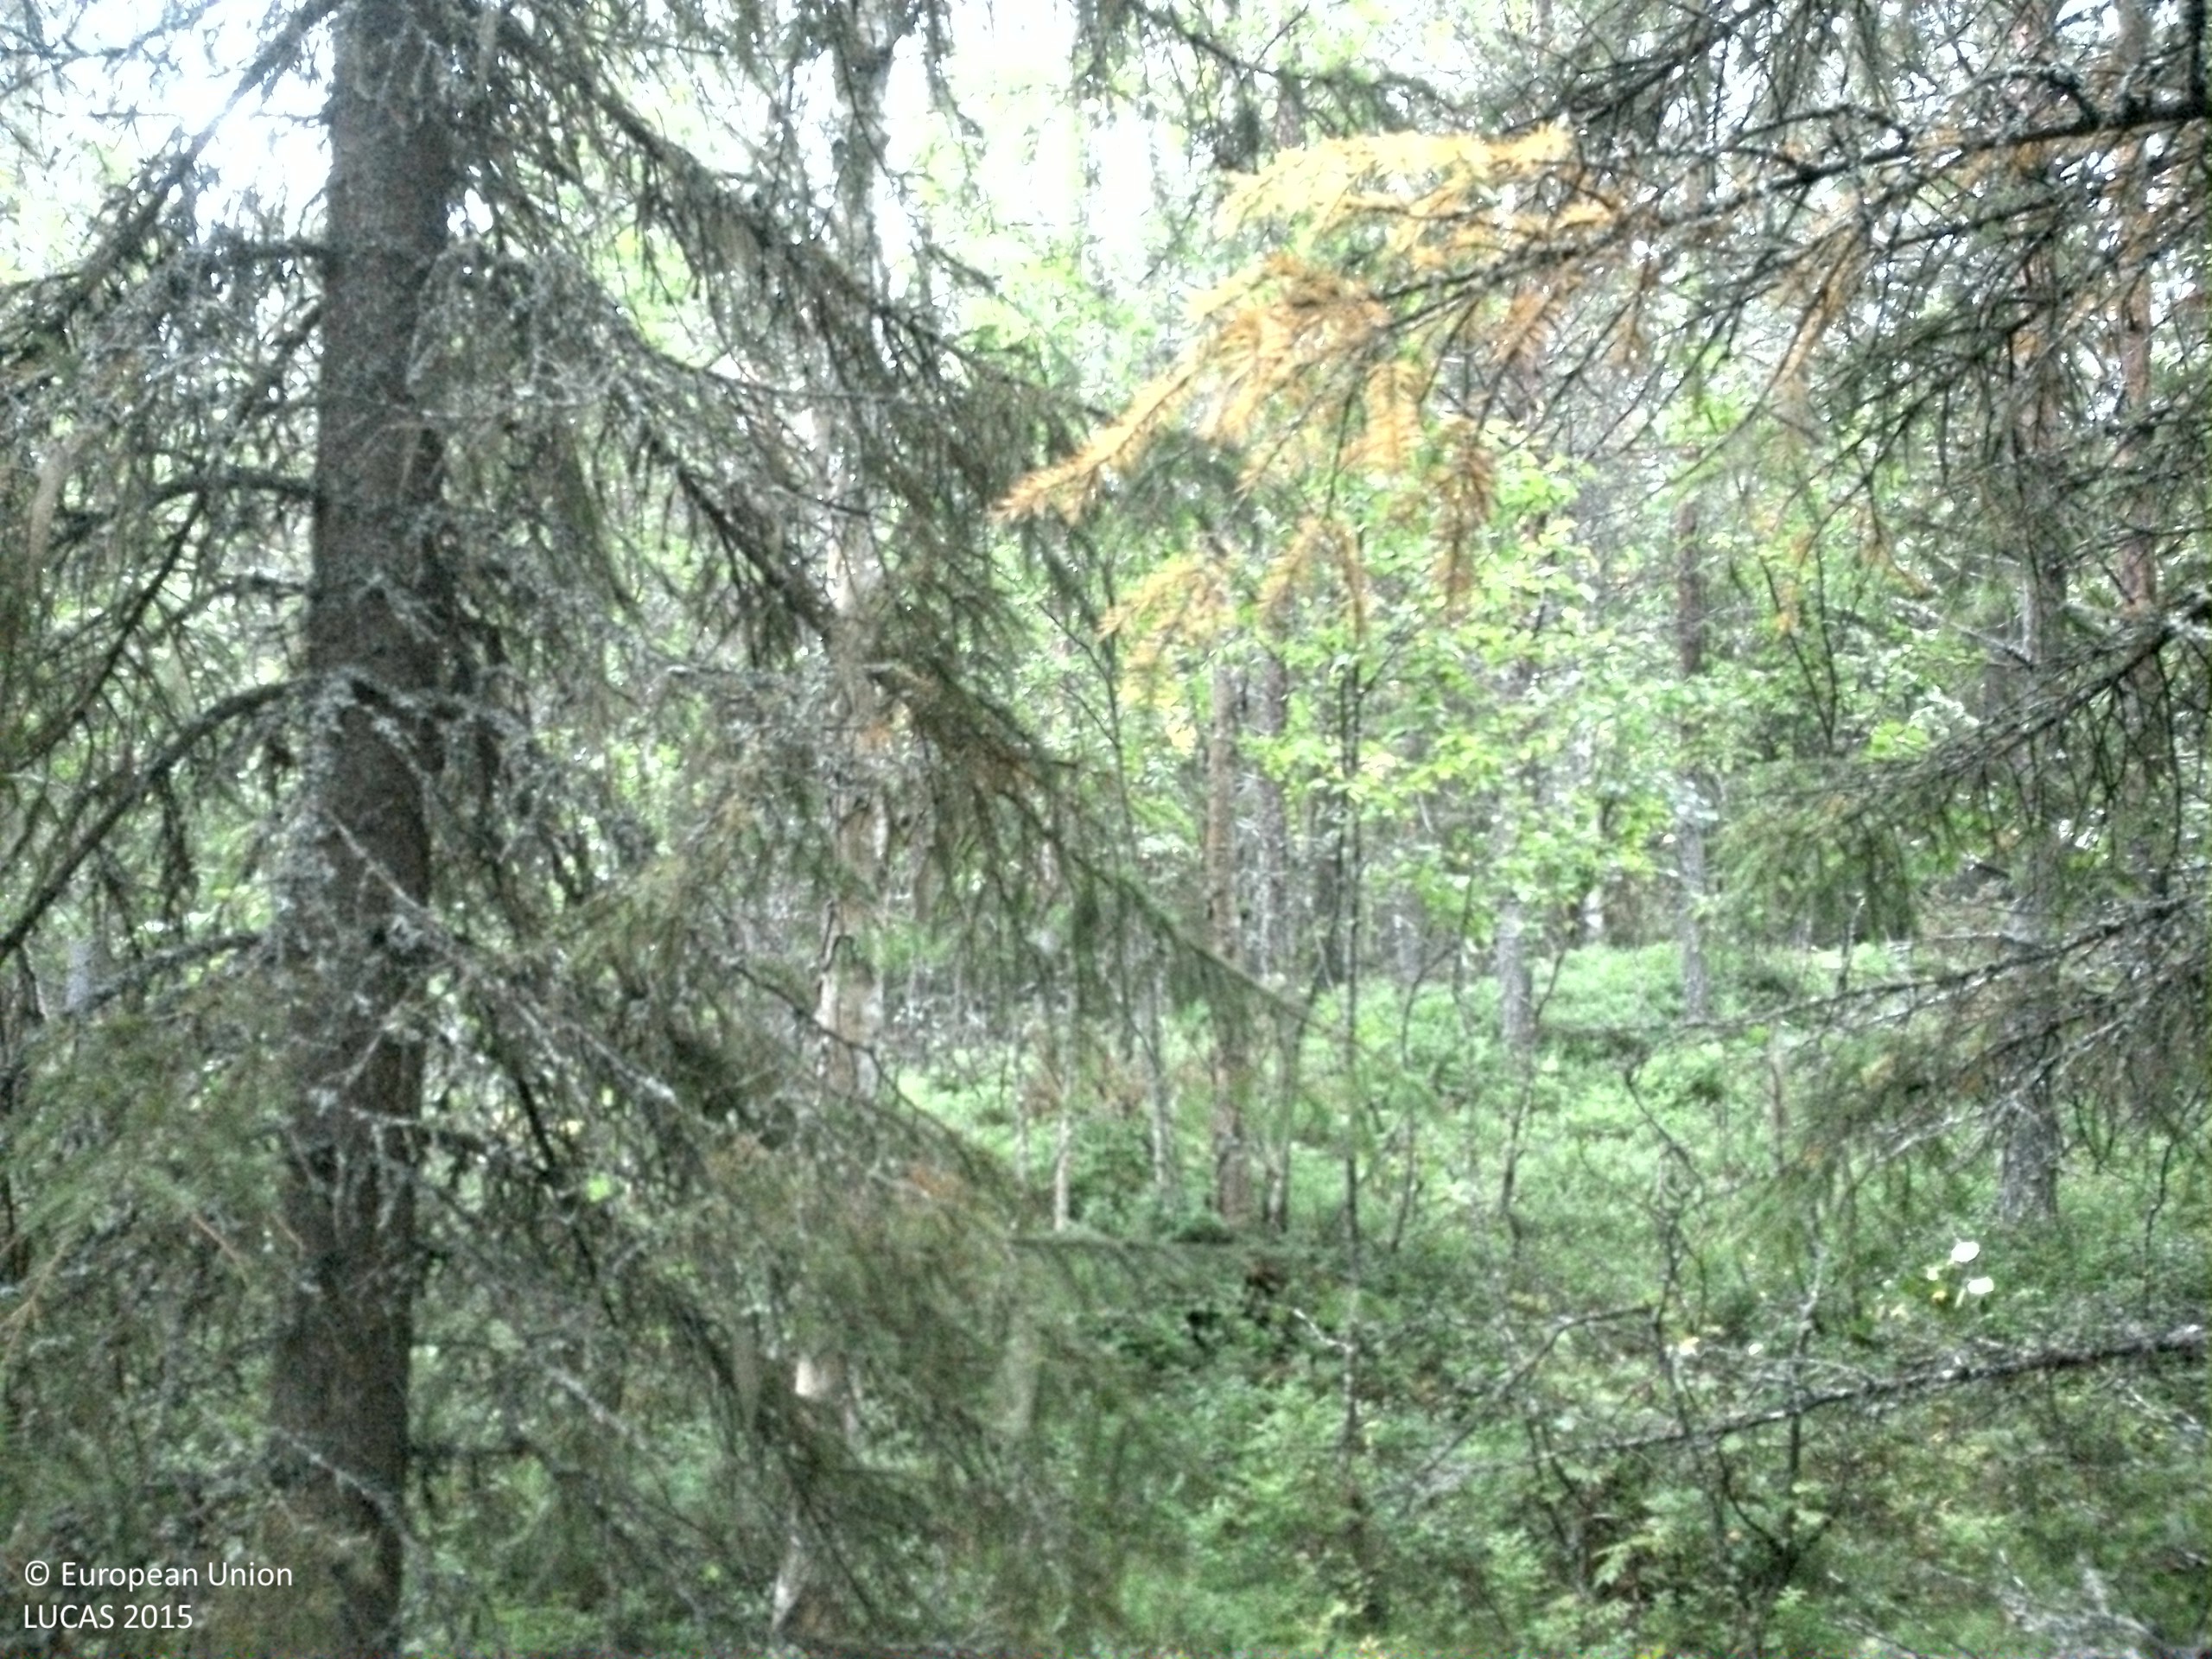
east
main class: Woodland
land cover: Spruce dominated coniferous woodland
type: boreal forest
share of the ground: > 75 %
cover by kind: coniferous forest trees 75 %, shrubs 15 %, broadleaved forest trees 10 %
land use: Forestry
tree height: > 5 m
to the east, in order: Spruce dominated coniferous woodland; Pine dominated coniferous woodland; Rivers and streams; Spruce dominated coniferous woodland
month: August
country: SE
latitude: 63.8467
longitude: 17.3530
